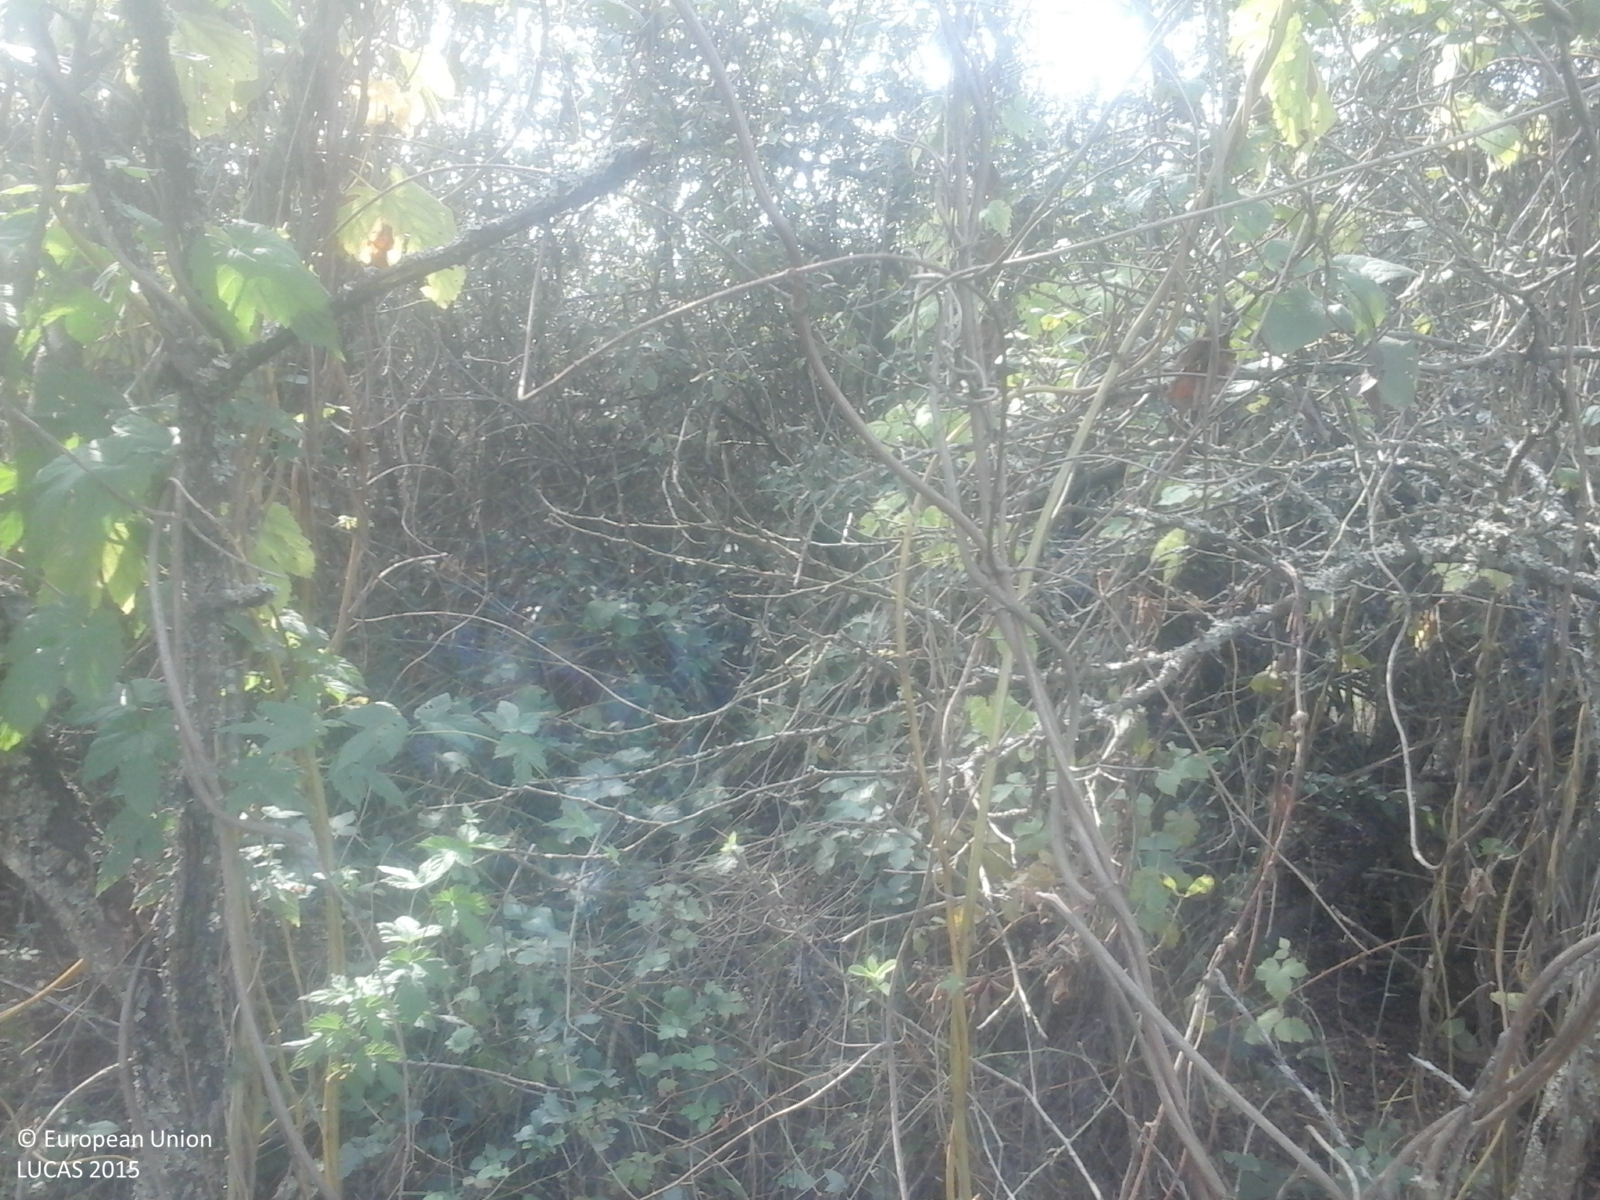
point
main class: Shrubland
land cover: Shrubland with sparse tree cover
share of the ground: > 75 %
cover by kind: shrubs 95 %, broadleaved forest trees 5 %
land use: Forestry
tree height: < 5 m
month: September
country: RO
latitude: 45.8191
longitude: 22.1537
